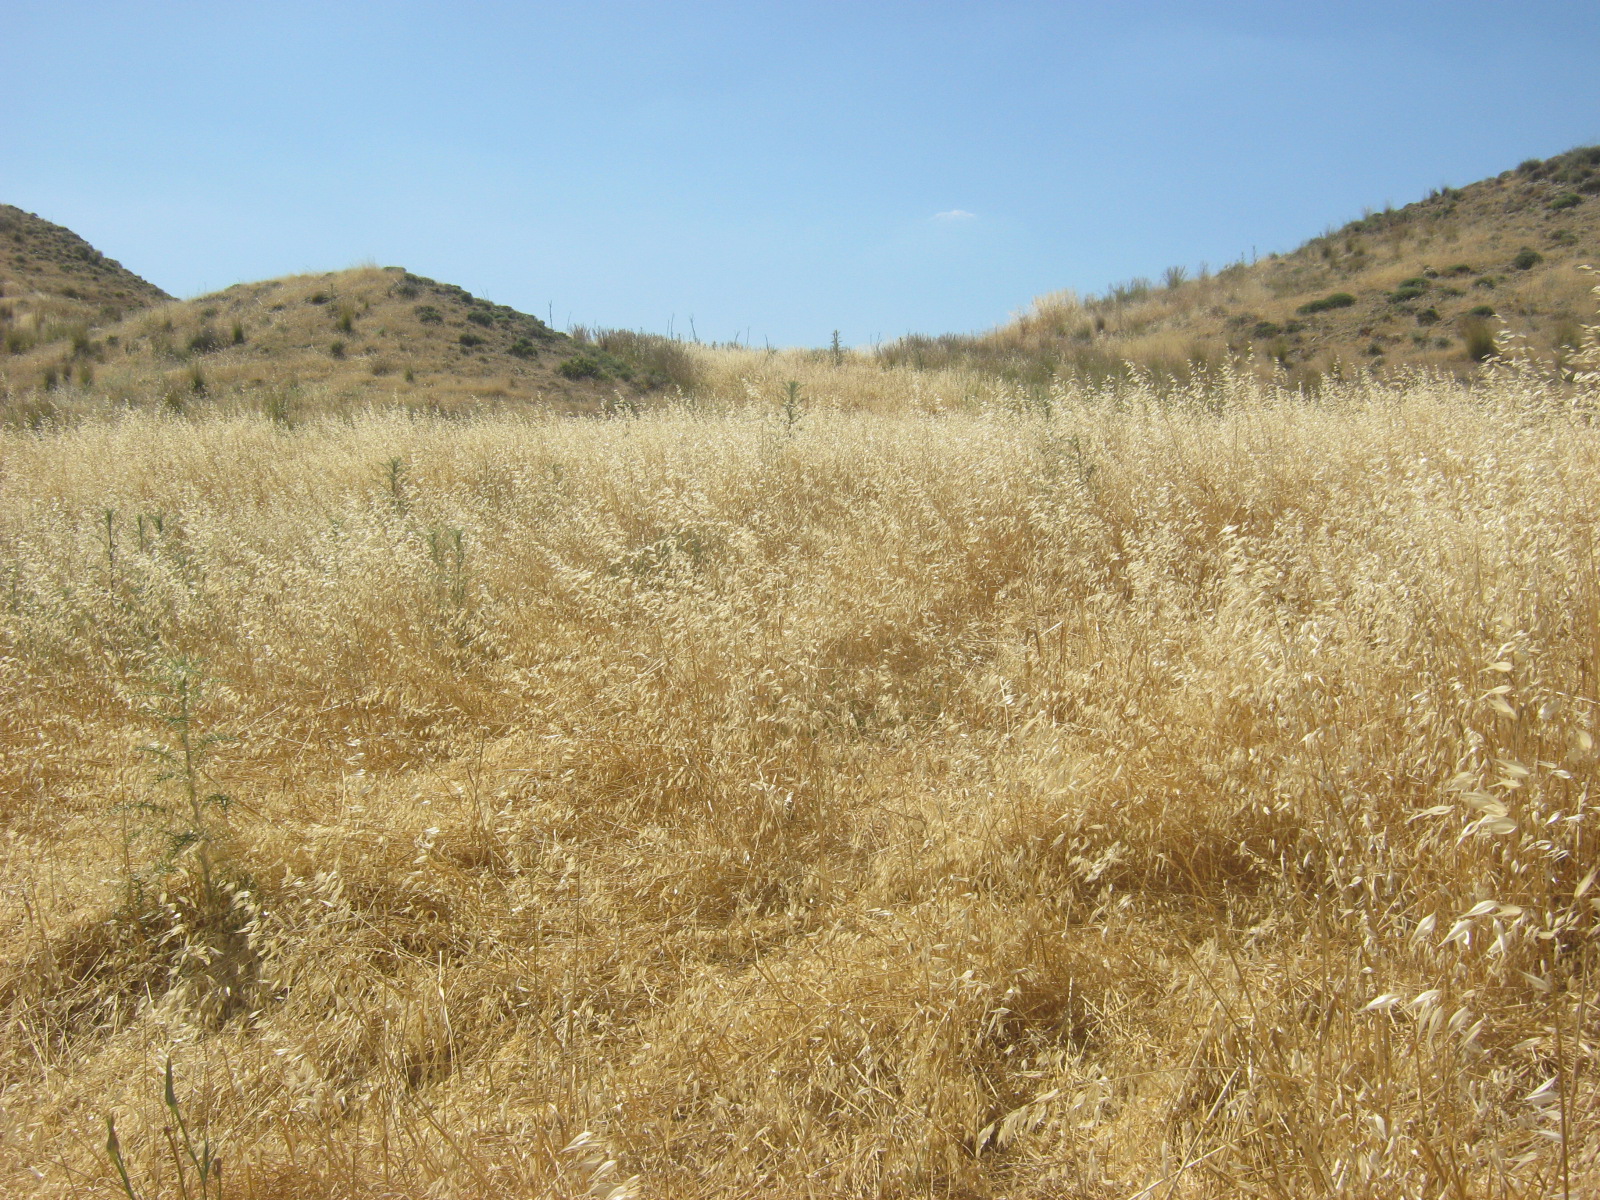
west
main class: Grassland
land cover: Spontaneously vegetated surfaces
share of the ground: > 75 %
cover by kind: herbaceous plants 100 %
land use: Semi-natural and natural areas not in use
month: May
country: CY
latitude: 35.0963
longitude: 33.2107
